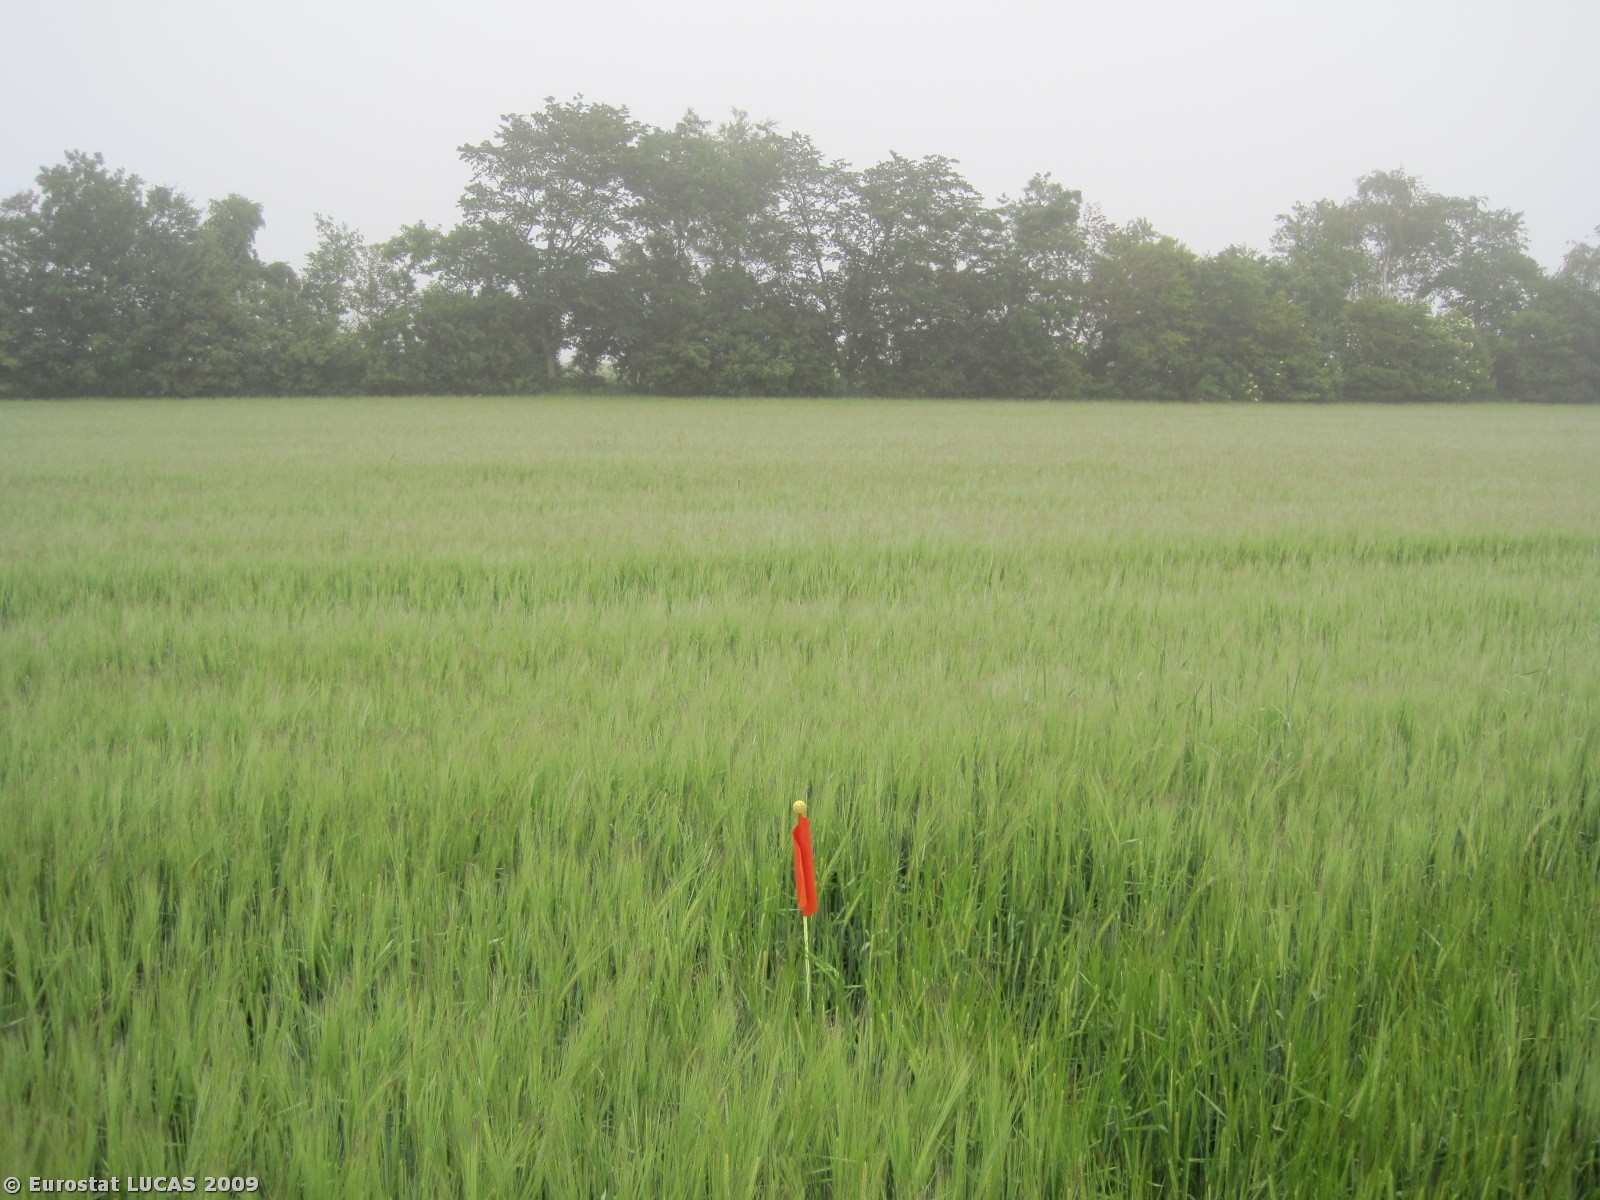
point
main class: Cropland
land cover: Barley
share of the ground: > 75 %
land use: Agriculture (excluding fallow land and kitchen gardens)
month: June
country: DK
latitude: 56.4893
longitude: 8.9781
